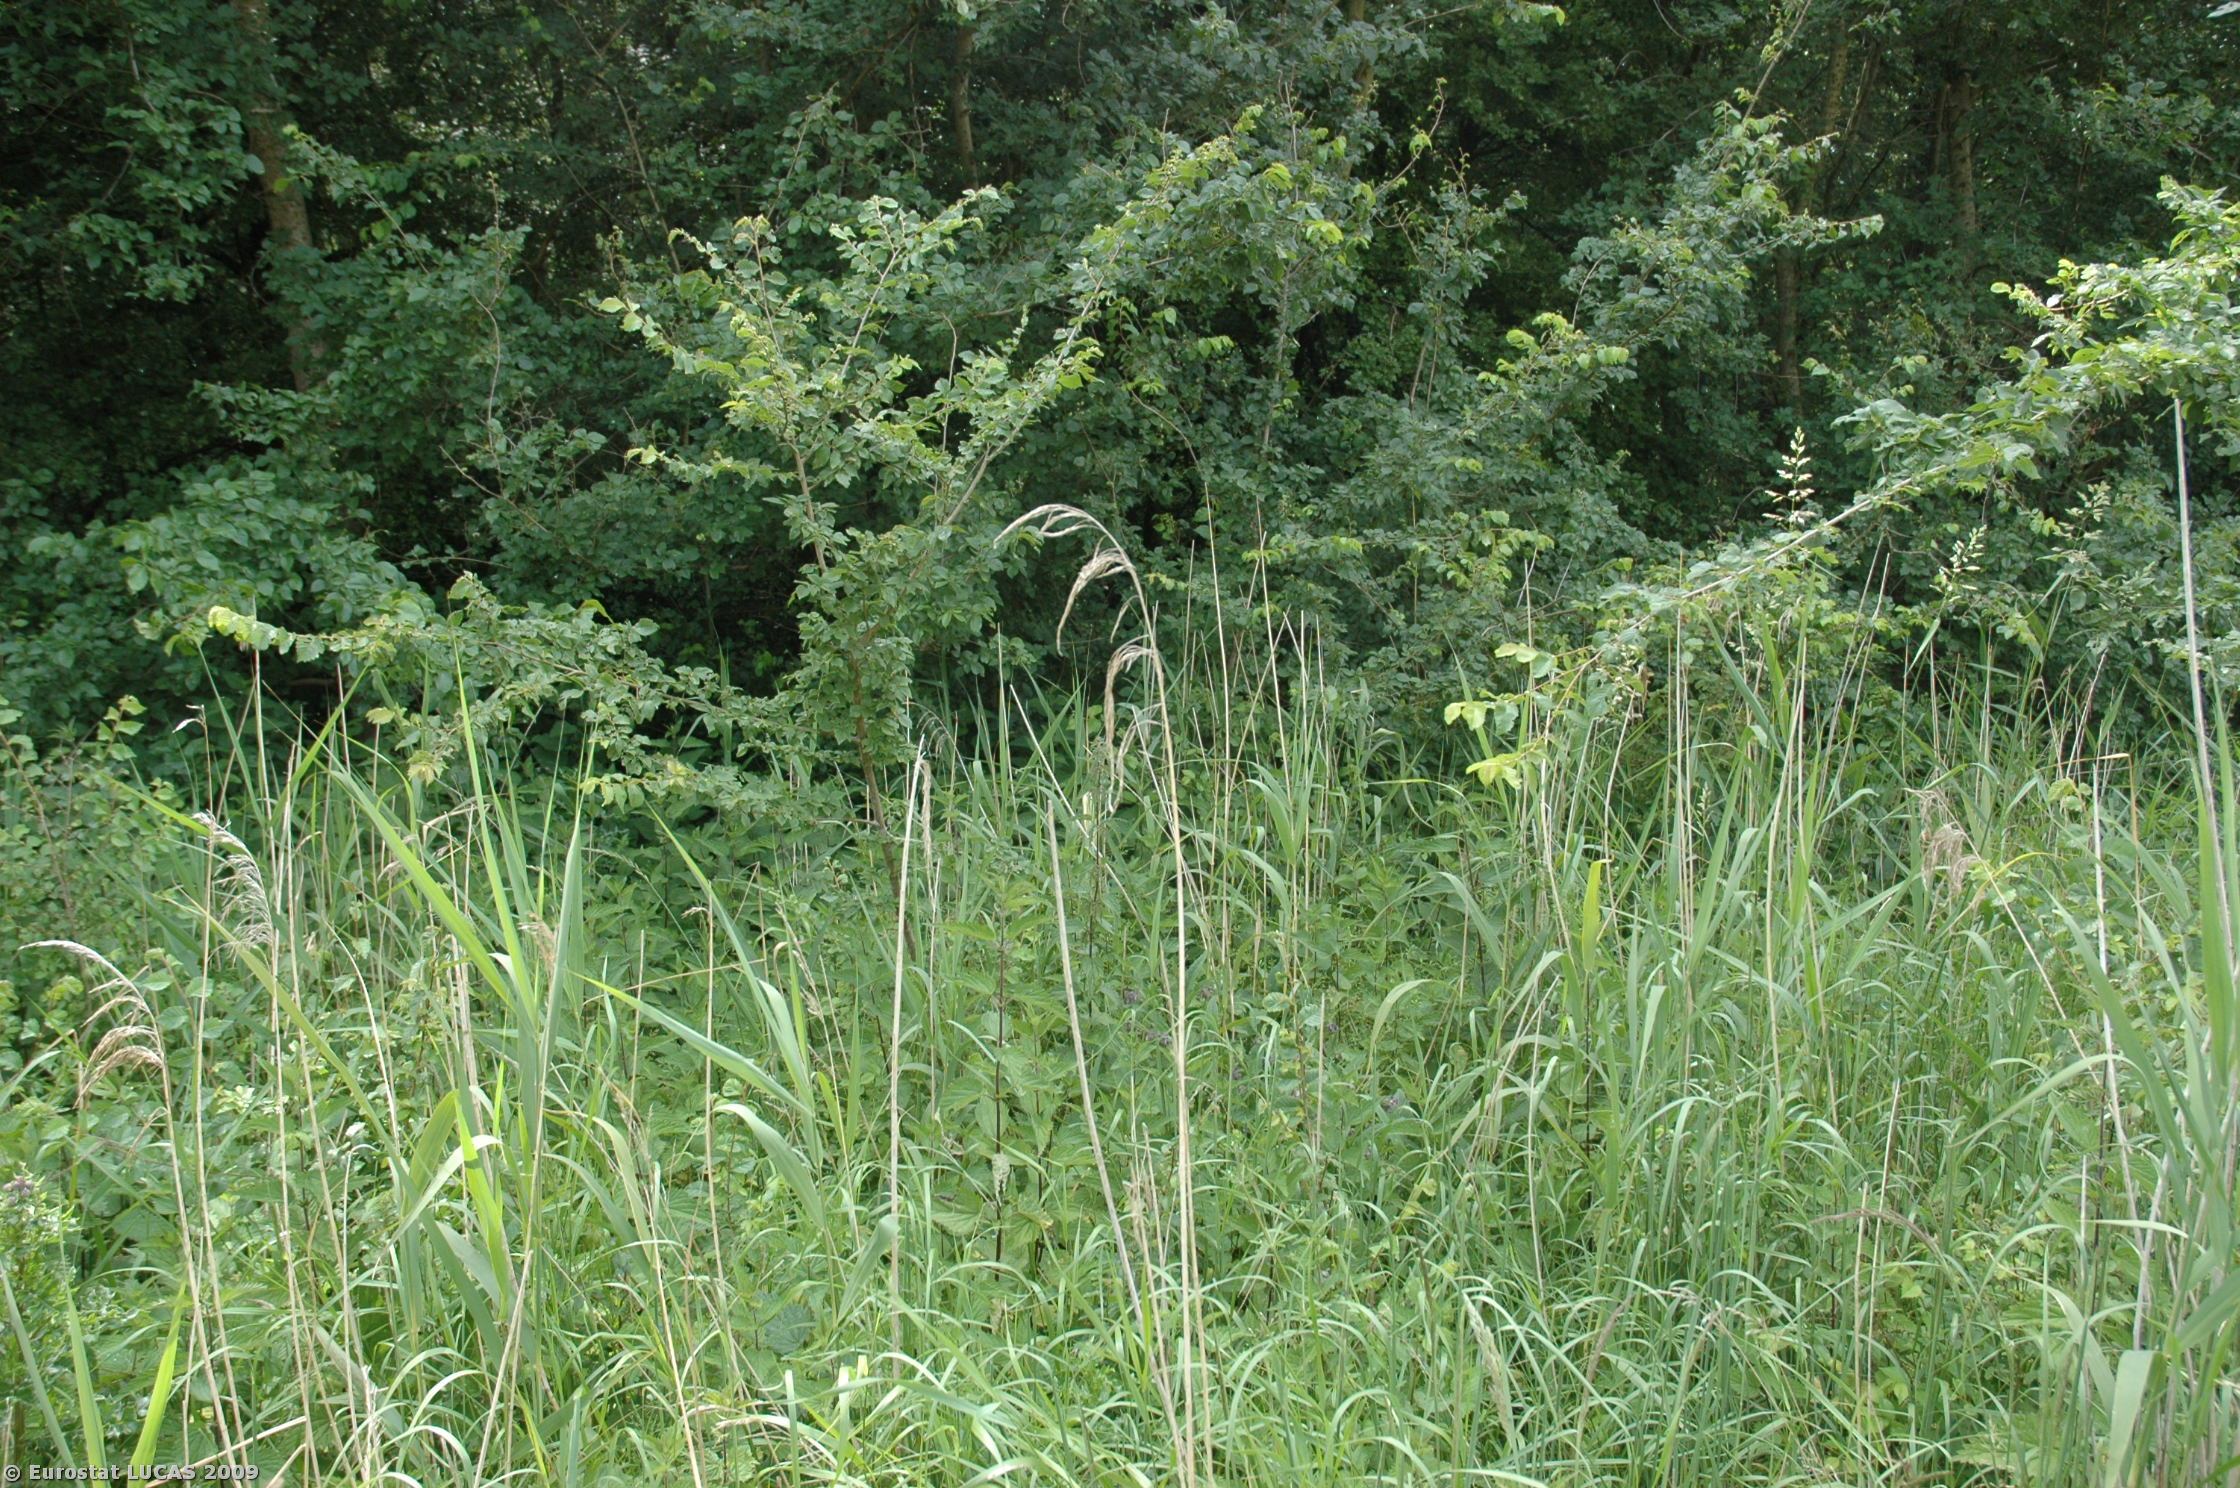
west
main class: Woodland
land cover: Broadleaved woodland
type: non-riverine alder, birch or aspen forest
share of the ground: > 75 %
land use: Unused
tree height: > 5 m
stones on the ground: < 10 %
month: June
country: NL
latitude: 52.6036
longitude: 5.6429
